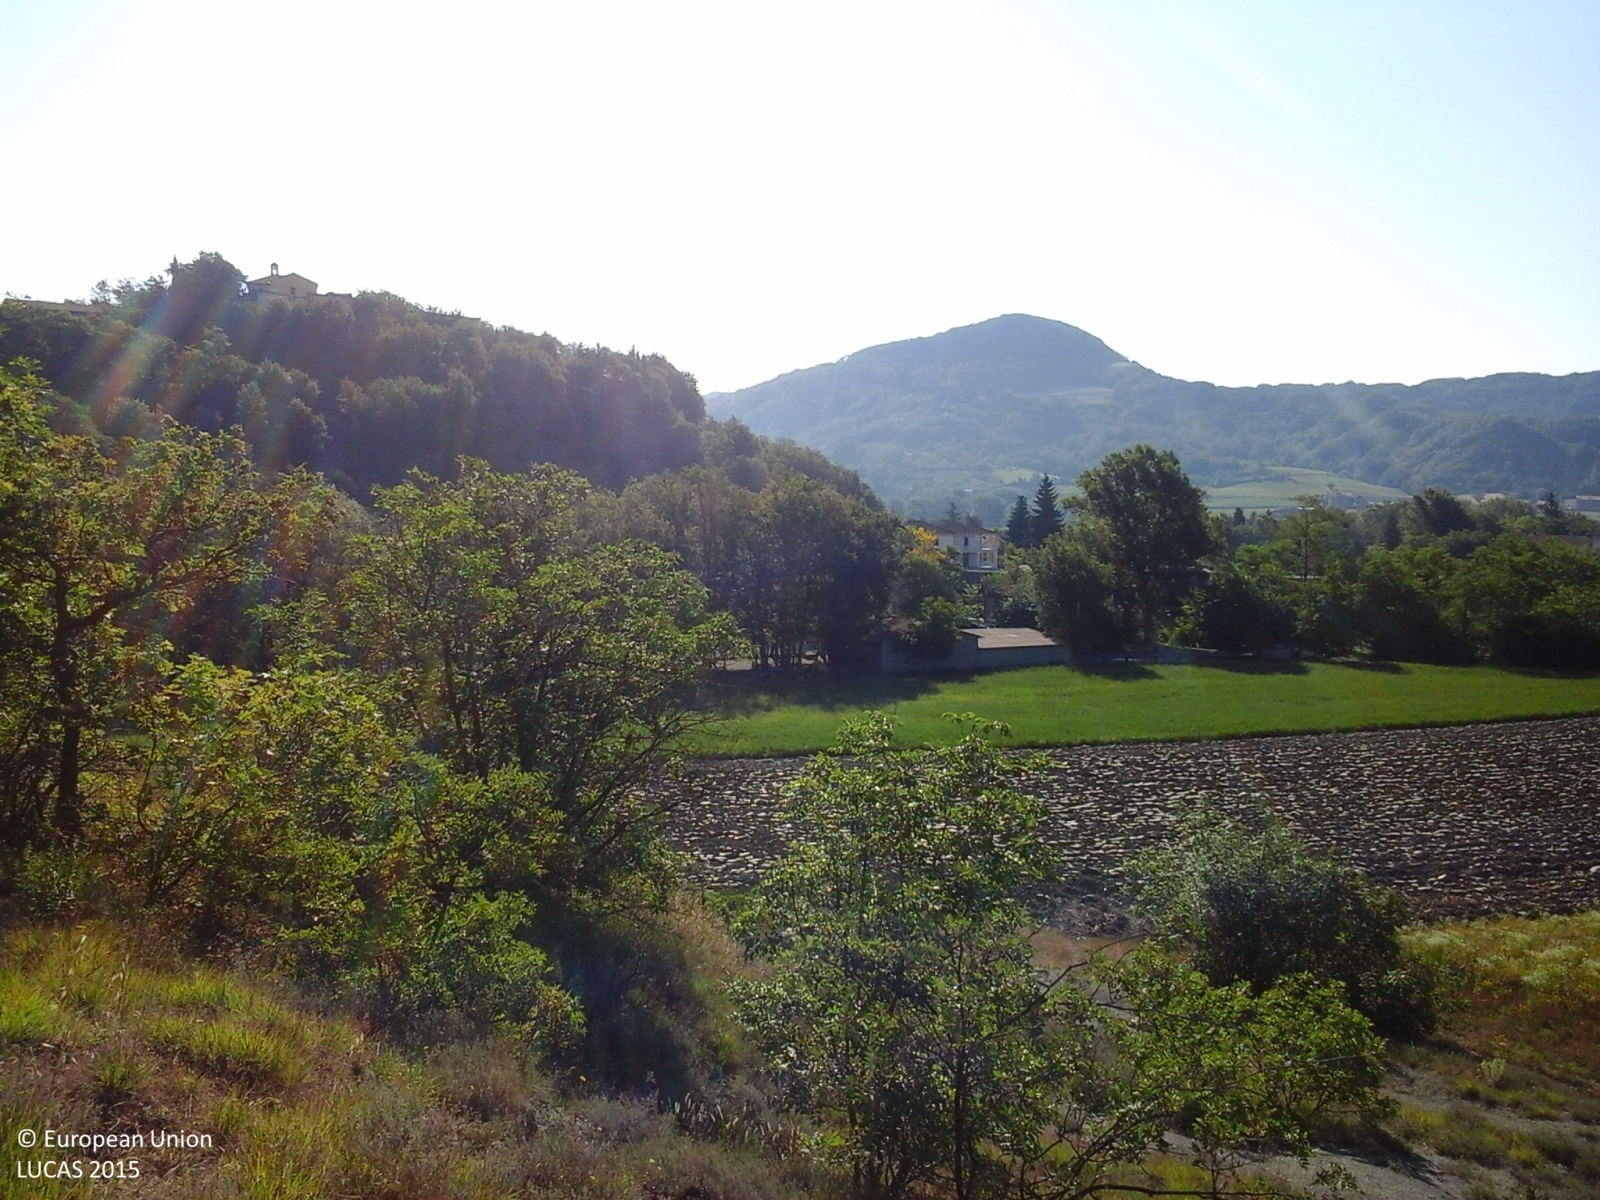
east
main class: Shrubland
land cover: Shrubland with sparse tree cover
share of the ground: > 75 %
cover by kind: herbaceous plants 50 %, consolidated bare surface 25 %, shrubs 20 %, broadleaved forest trees 5 %
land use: Semi-natural and natural areas not in use
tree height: < 5 m
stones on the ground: > 50 %
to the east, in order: Shrubland with sparse tree cover; Other bare soil; Lucerne; Dry stone walls; Broadleaved woodland; Artificial constructions in urban areas; Broadleaved woodland; Inland fresh running water; Abandoned hedges; Common wheat; Artificial constructions in urban areas
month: June
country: IT
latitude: 44.5716
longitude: 8.3287
